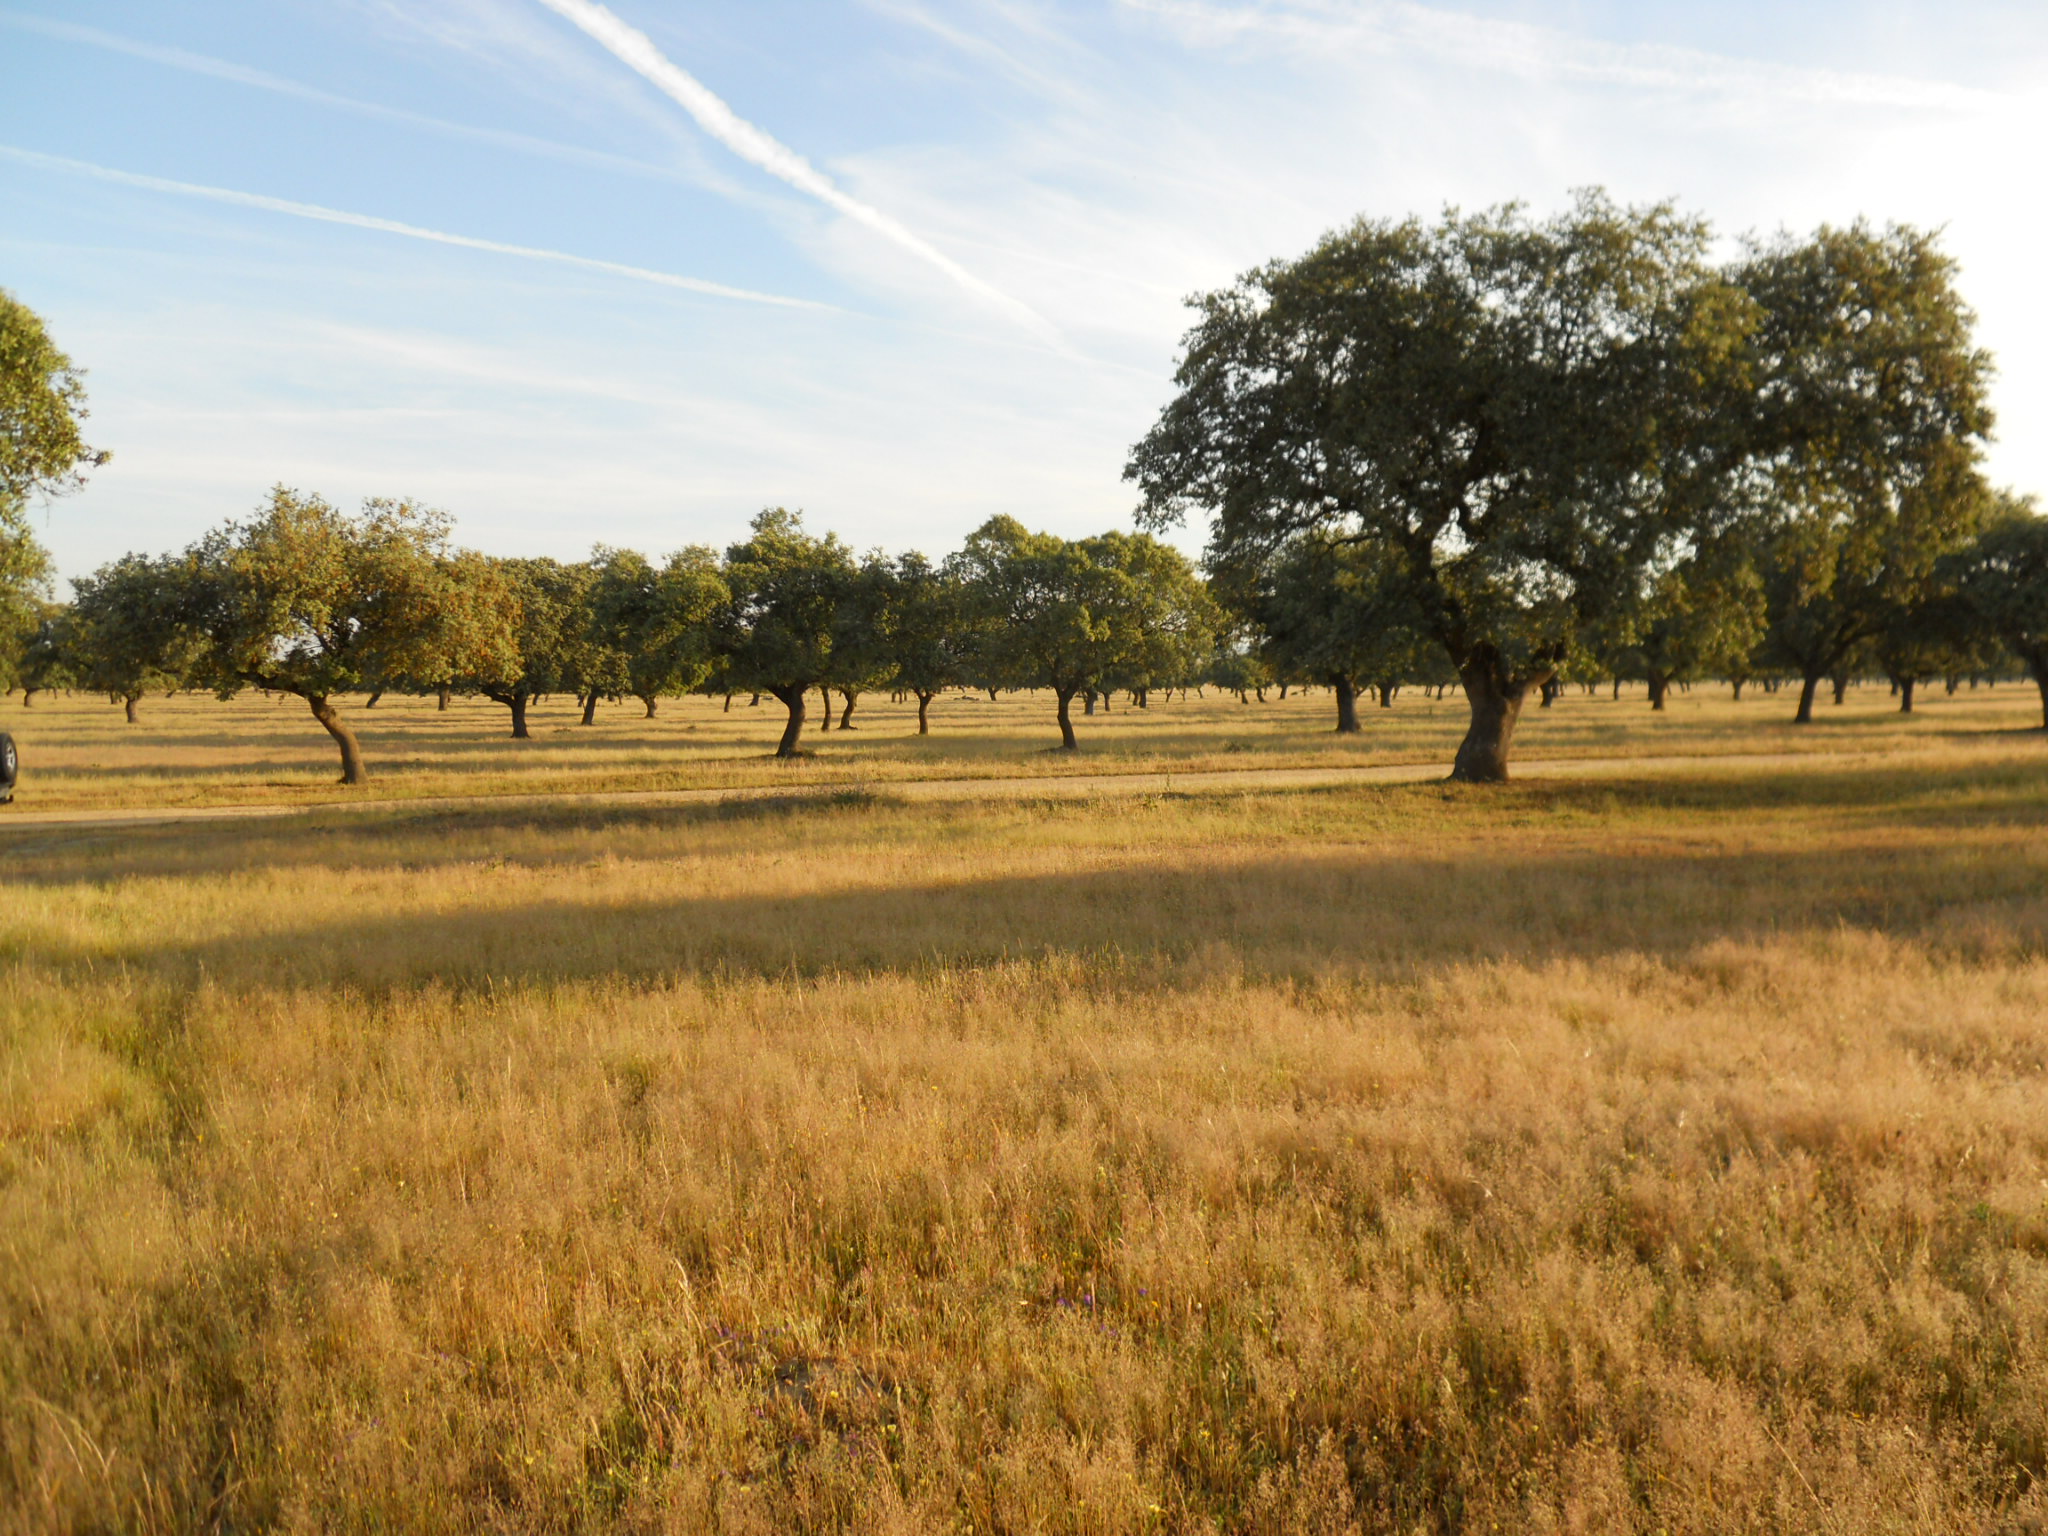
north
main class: Woodland
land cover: Broadleaved woodland
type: broadleaved evergreen forest
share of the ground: 10 - 25 %
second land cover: Grassland without tree/shrub cover
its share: > 75 %
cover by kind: herbaceous plants 80 %, broadleaved forest trees 20 %
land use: Forestry
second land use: Agriculture (excluding fallow land and kitchen gardens)
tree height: > 5 m
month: May
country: ES
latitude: 39.2682
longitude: -6.3723
